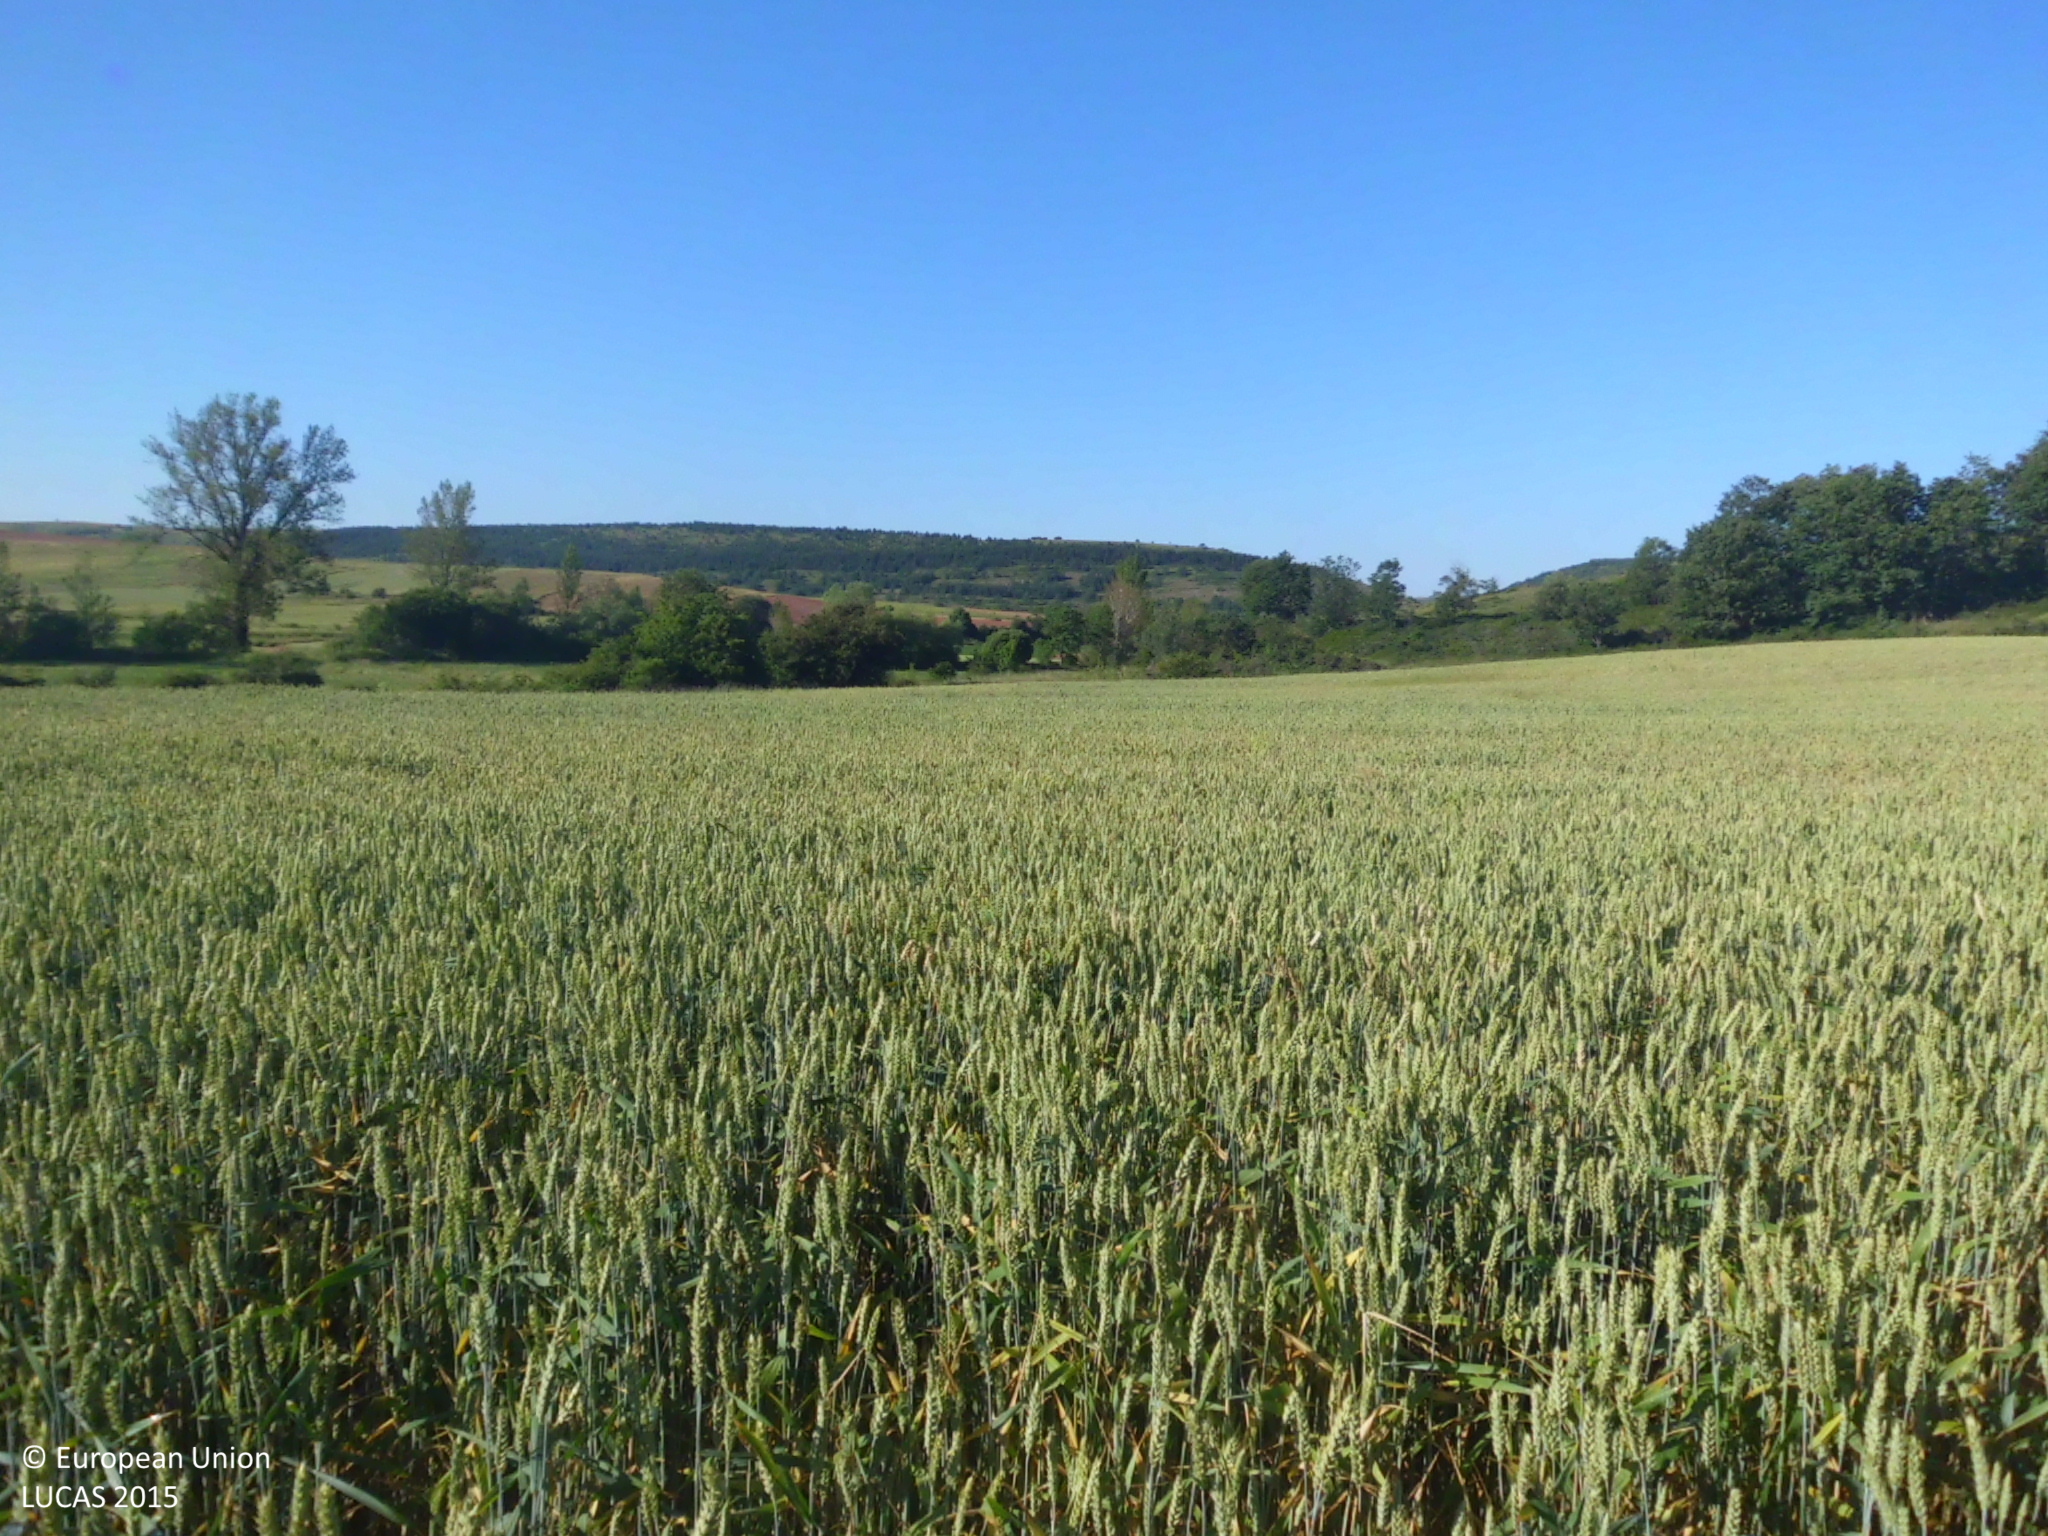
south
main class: Cropland
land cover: Common wheat
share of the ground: > 75 %
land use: Agriculture (excluding fallow land and kitchen gardens)
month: June
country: ES
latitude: 42.6548
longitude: -3.9375
